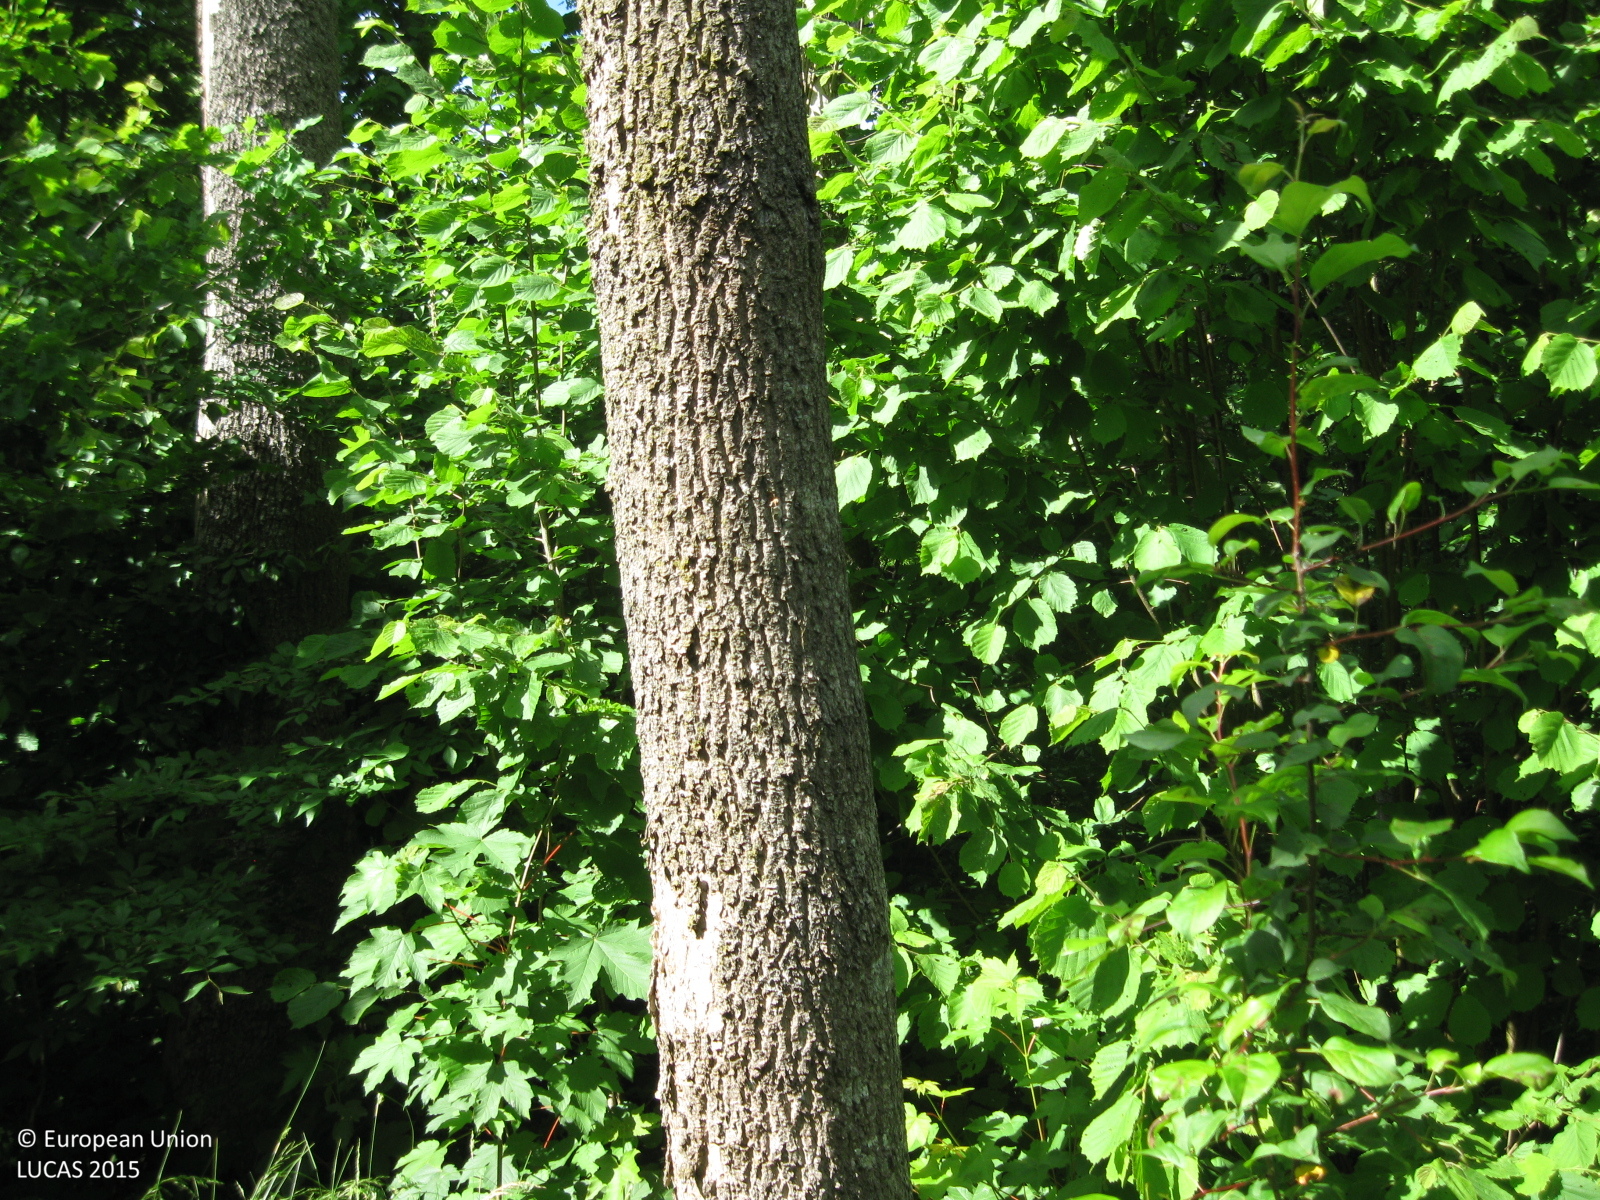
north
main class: Woodland
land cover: Broadleaved woodland
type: non-riverine alder, birch or aspen forest
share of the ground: 50 - 75 %
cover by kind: broadleaved forest trees 70 %, shrubs 15 %, herbaceous plants 15 %
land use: Forestry
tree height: > 5 m
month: June
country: LT
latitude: 55.3788
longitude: 23.8324
